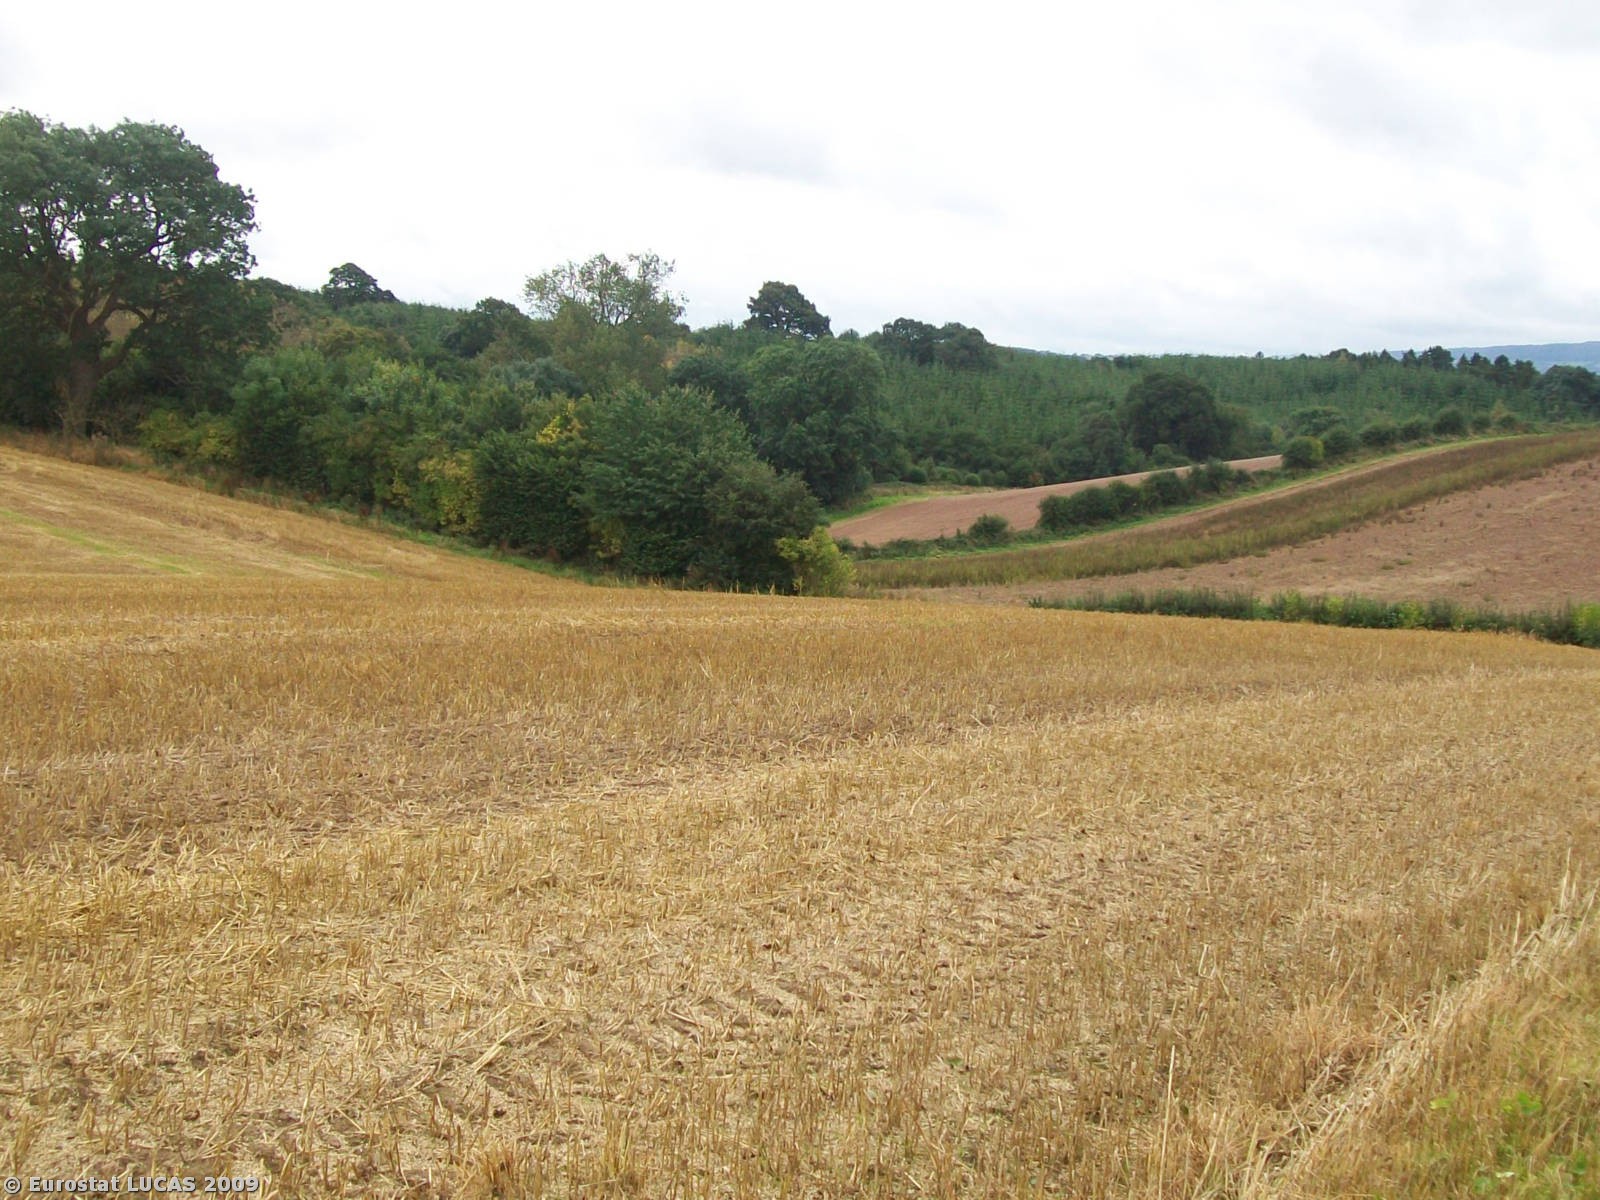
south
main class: Cropland
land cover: Common wheat
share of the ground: < 10 %
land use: Agriculture (excluding fallow land and kitchen gardens)
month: September
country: GB
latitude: 52.5832
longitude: -2.5380
